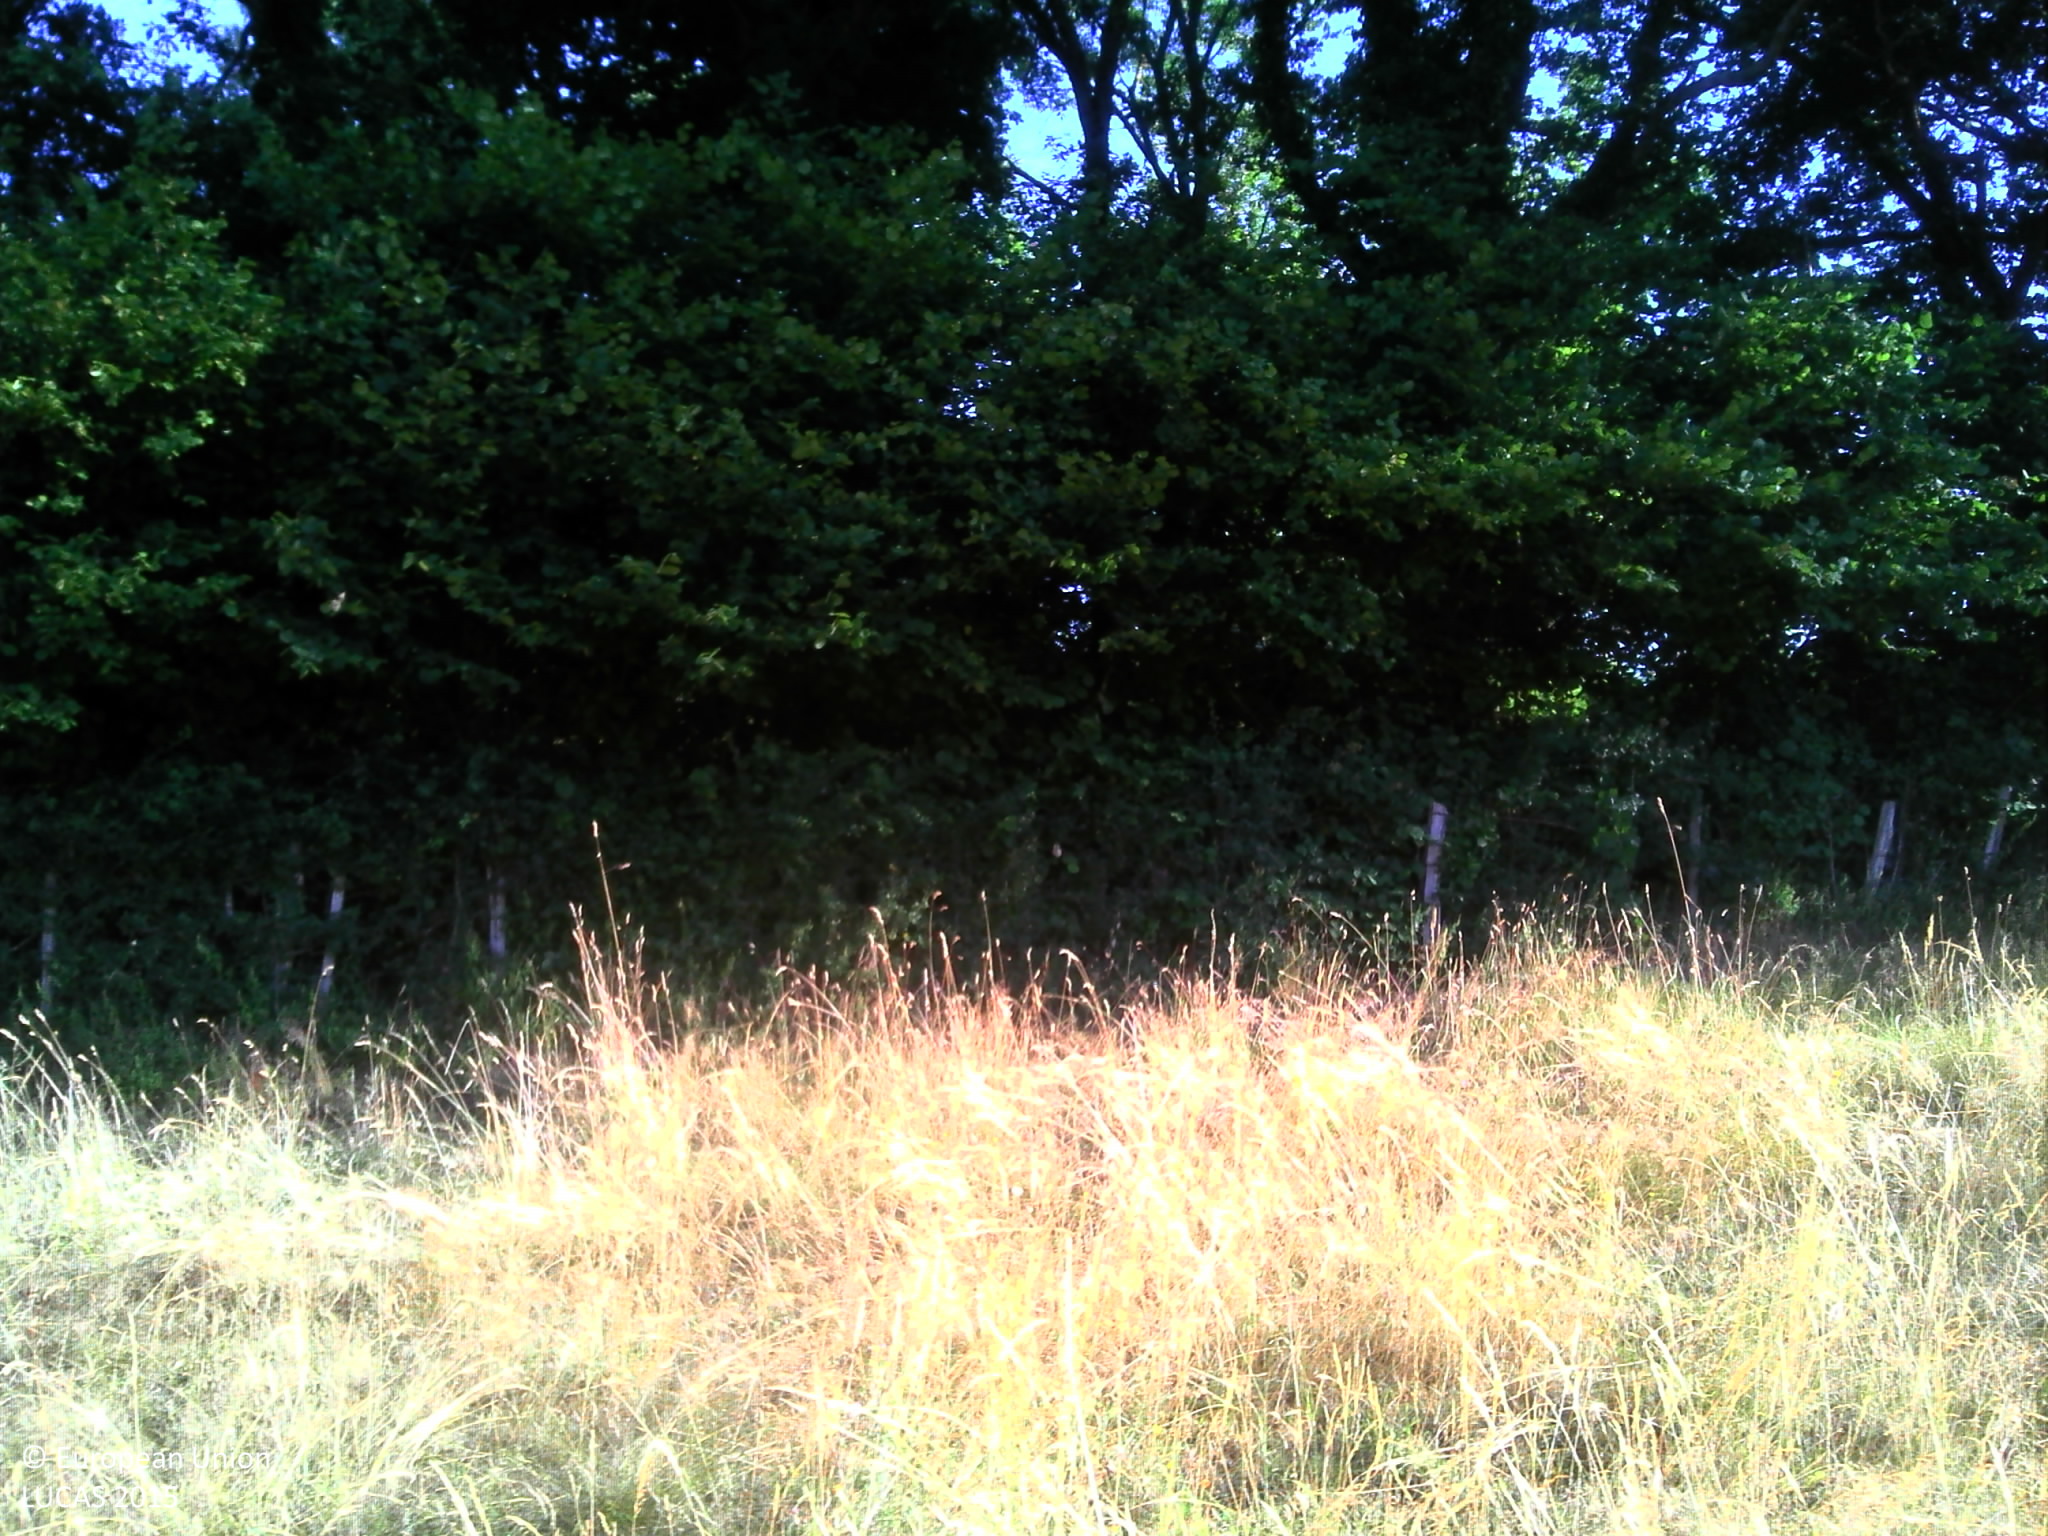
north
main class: Grassland
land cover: Grassland without tree/shrub cover
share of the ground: > 75 %
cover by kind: herbaceous plants 100 %
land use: Agriculture (excluding fallow land and kitchen gardens)
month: June
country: FR
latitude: 46.3889
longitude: 4.4749
